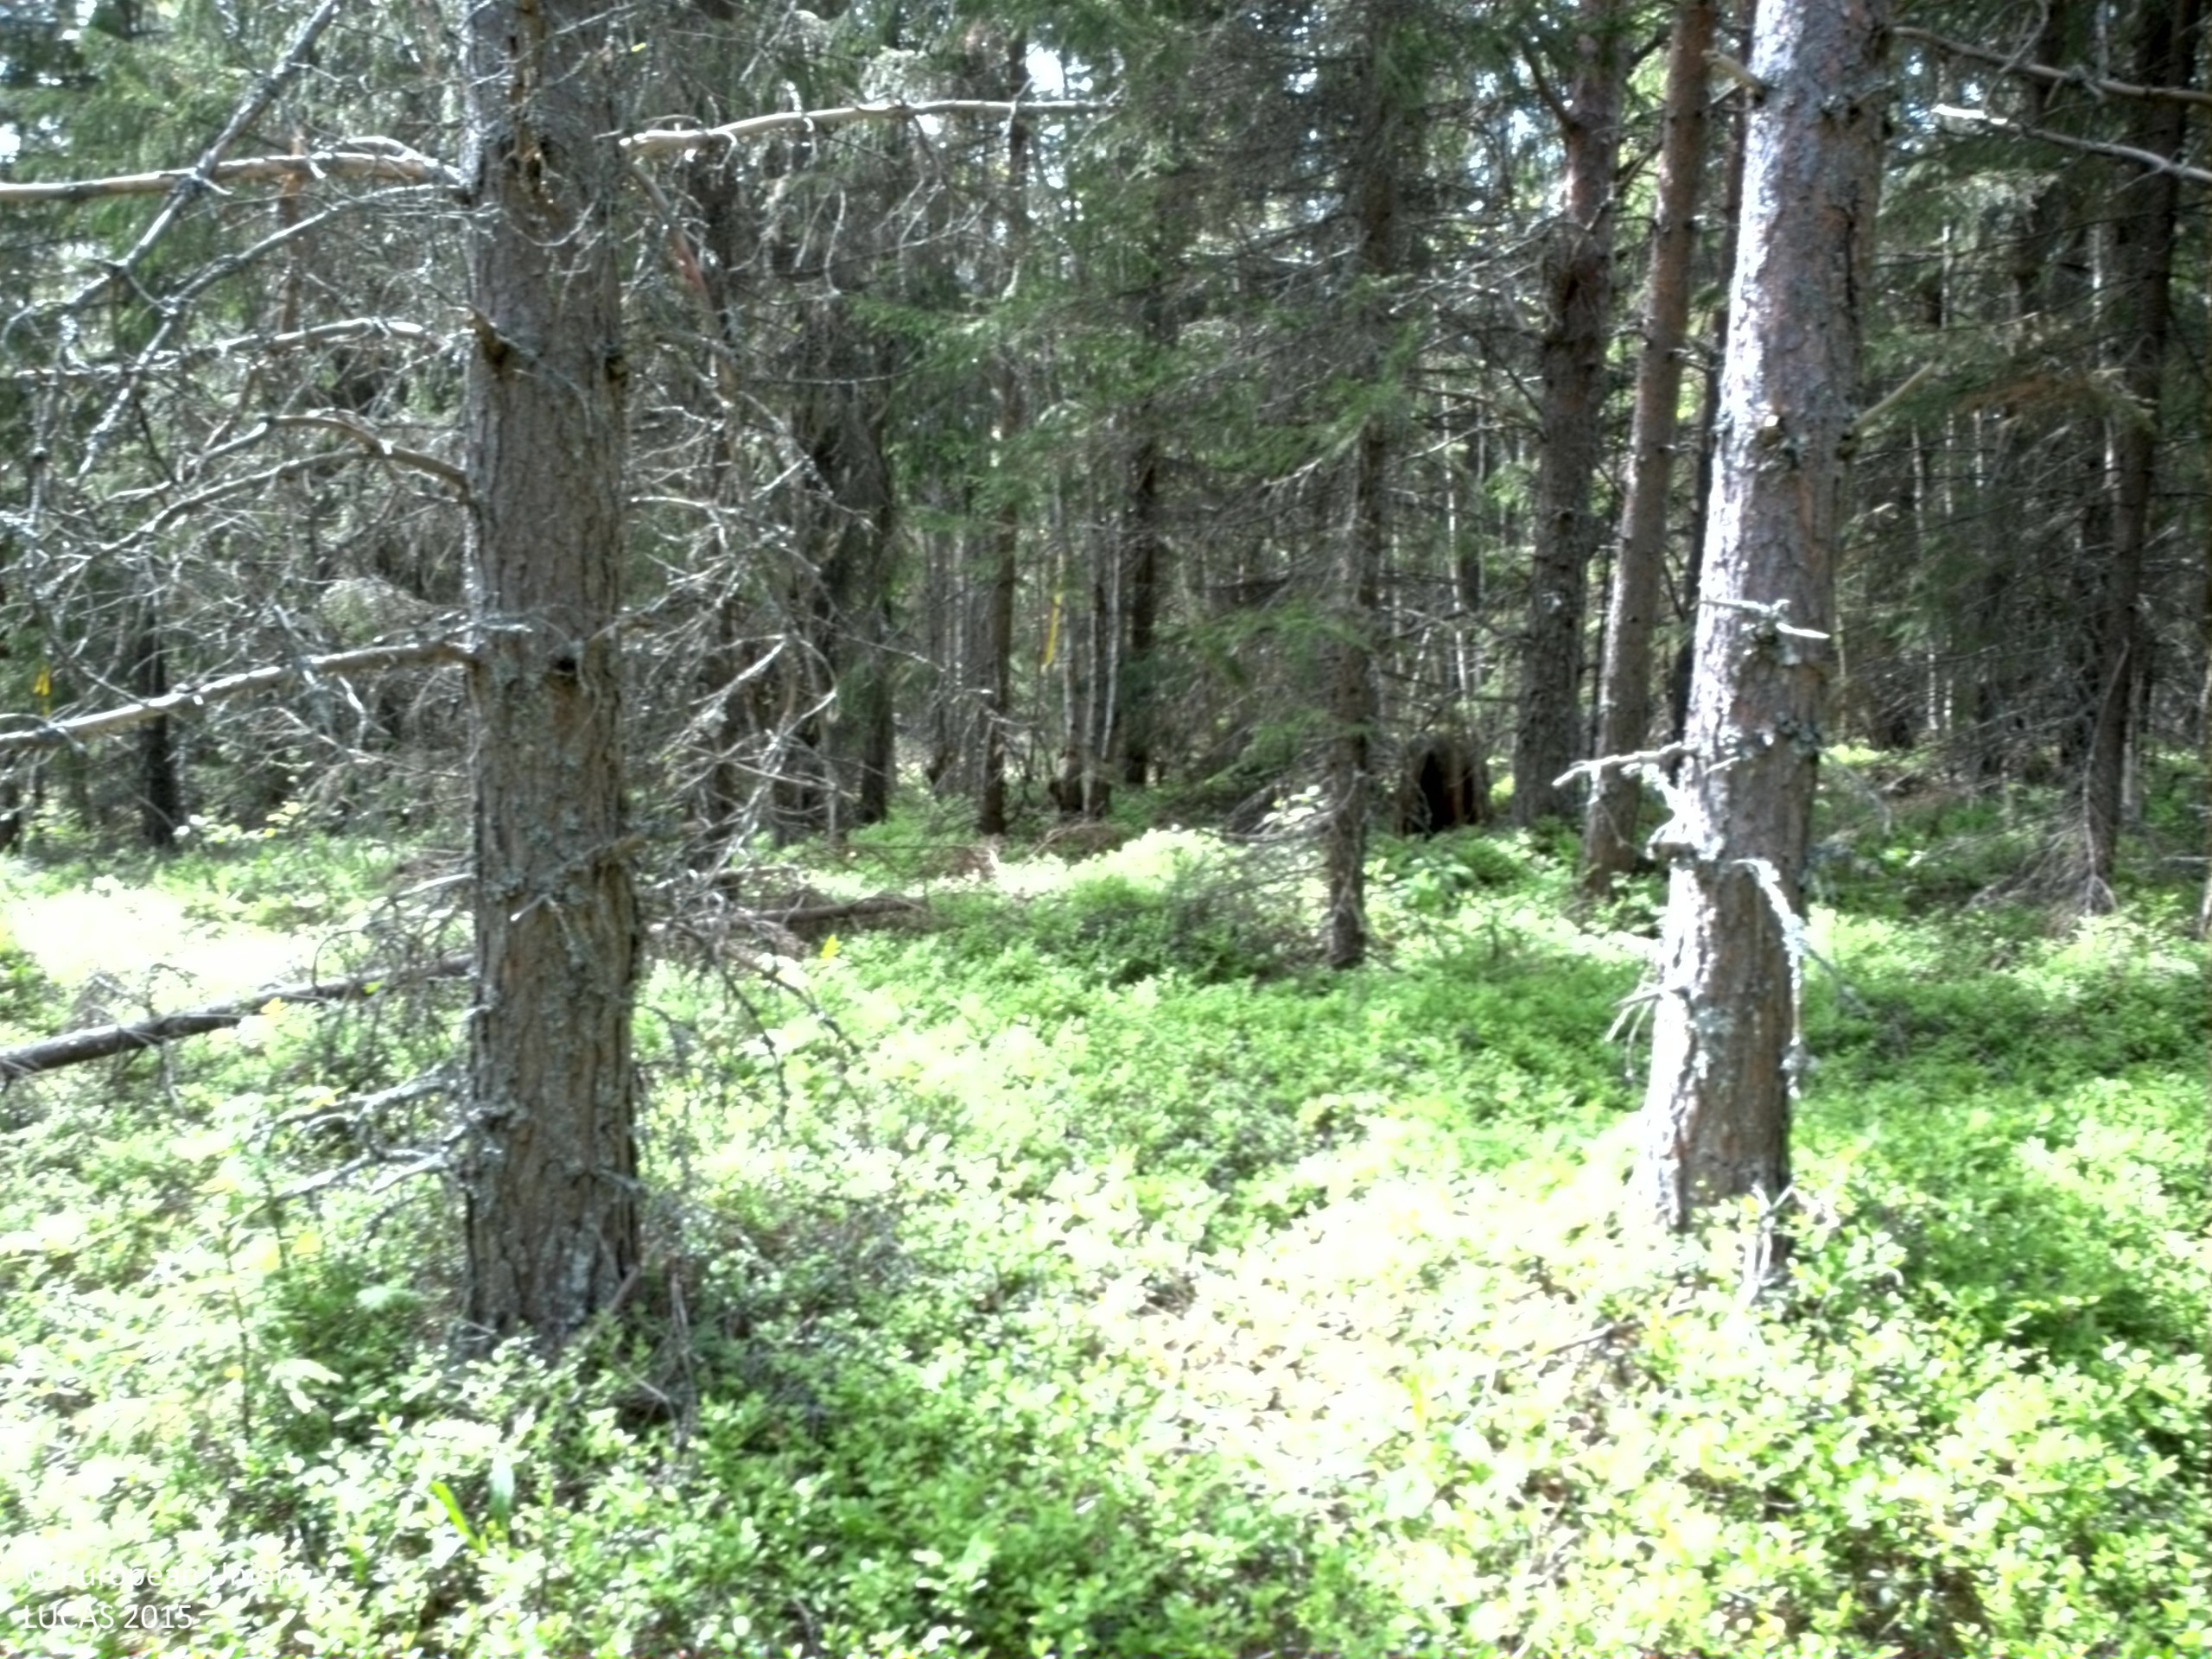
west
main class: Woodland
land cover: Spruce dominated mixed woodland
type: boreal forest
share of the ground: 50 - 75 %
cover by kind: coniferous forest trees 45 %, shrubs 40 %, broadleaved forest trees 15 %
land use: Forestry
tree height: > 5 m
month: June
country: SE
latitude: 63.2402
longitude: 17.8795
